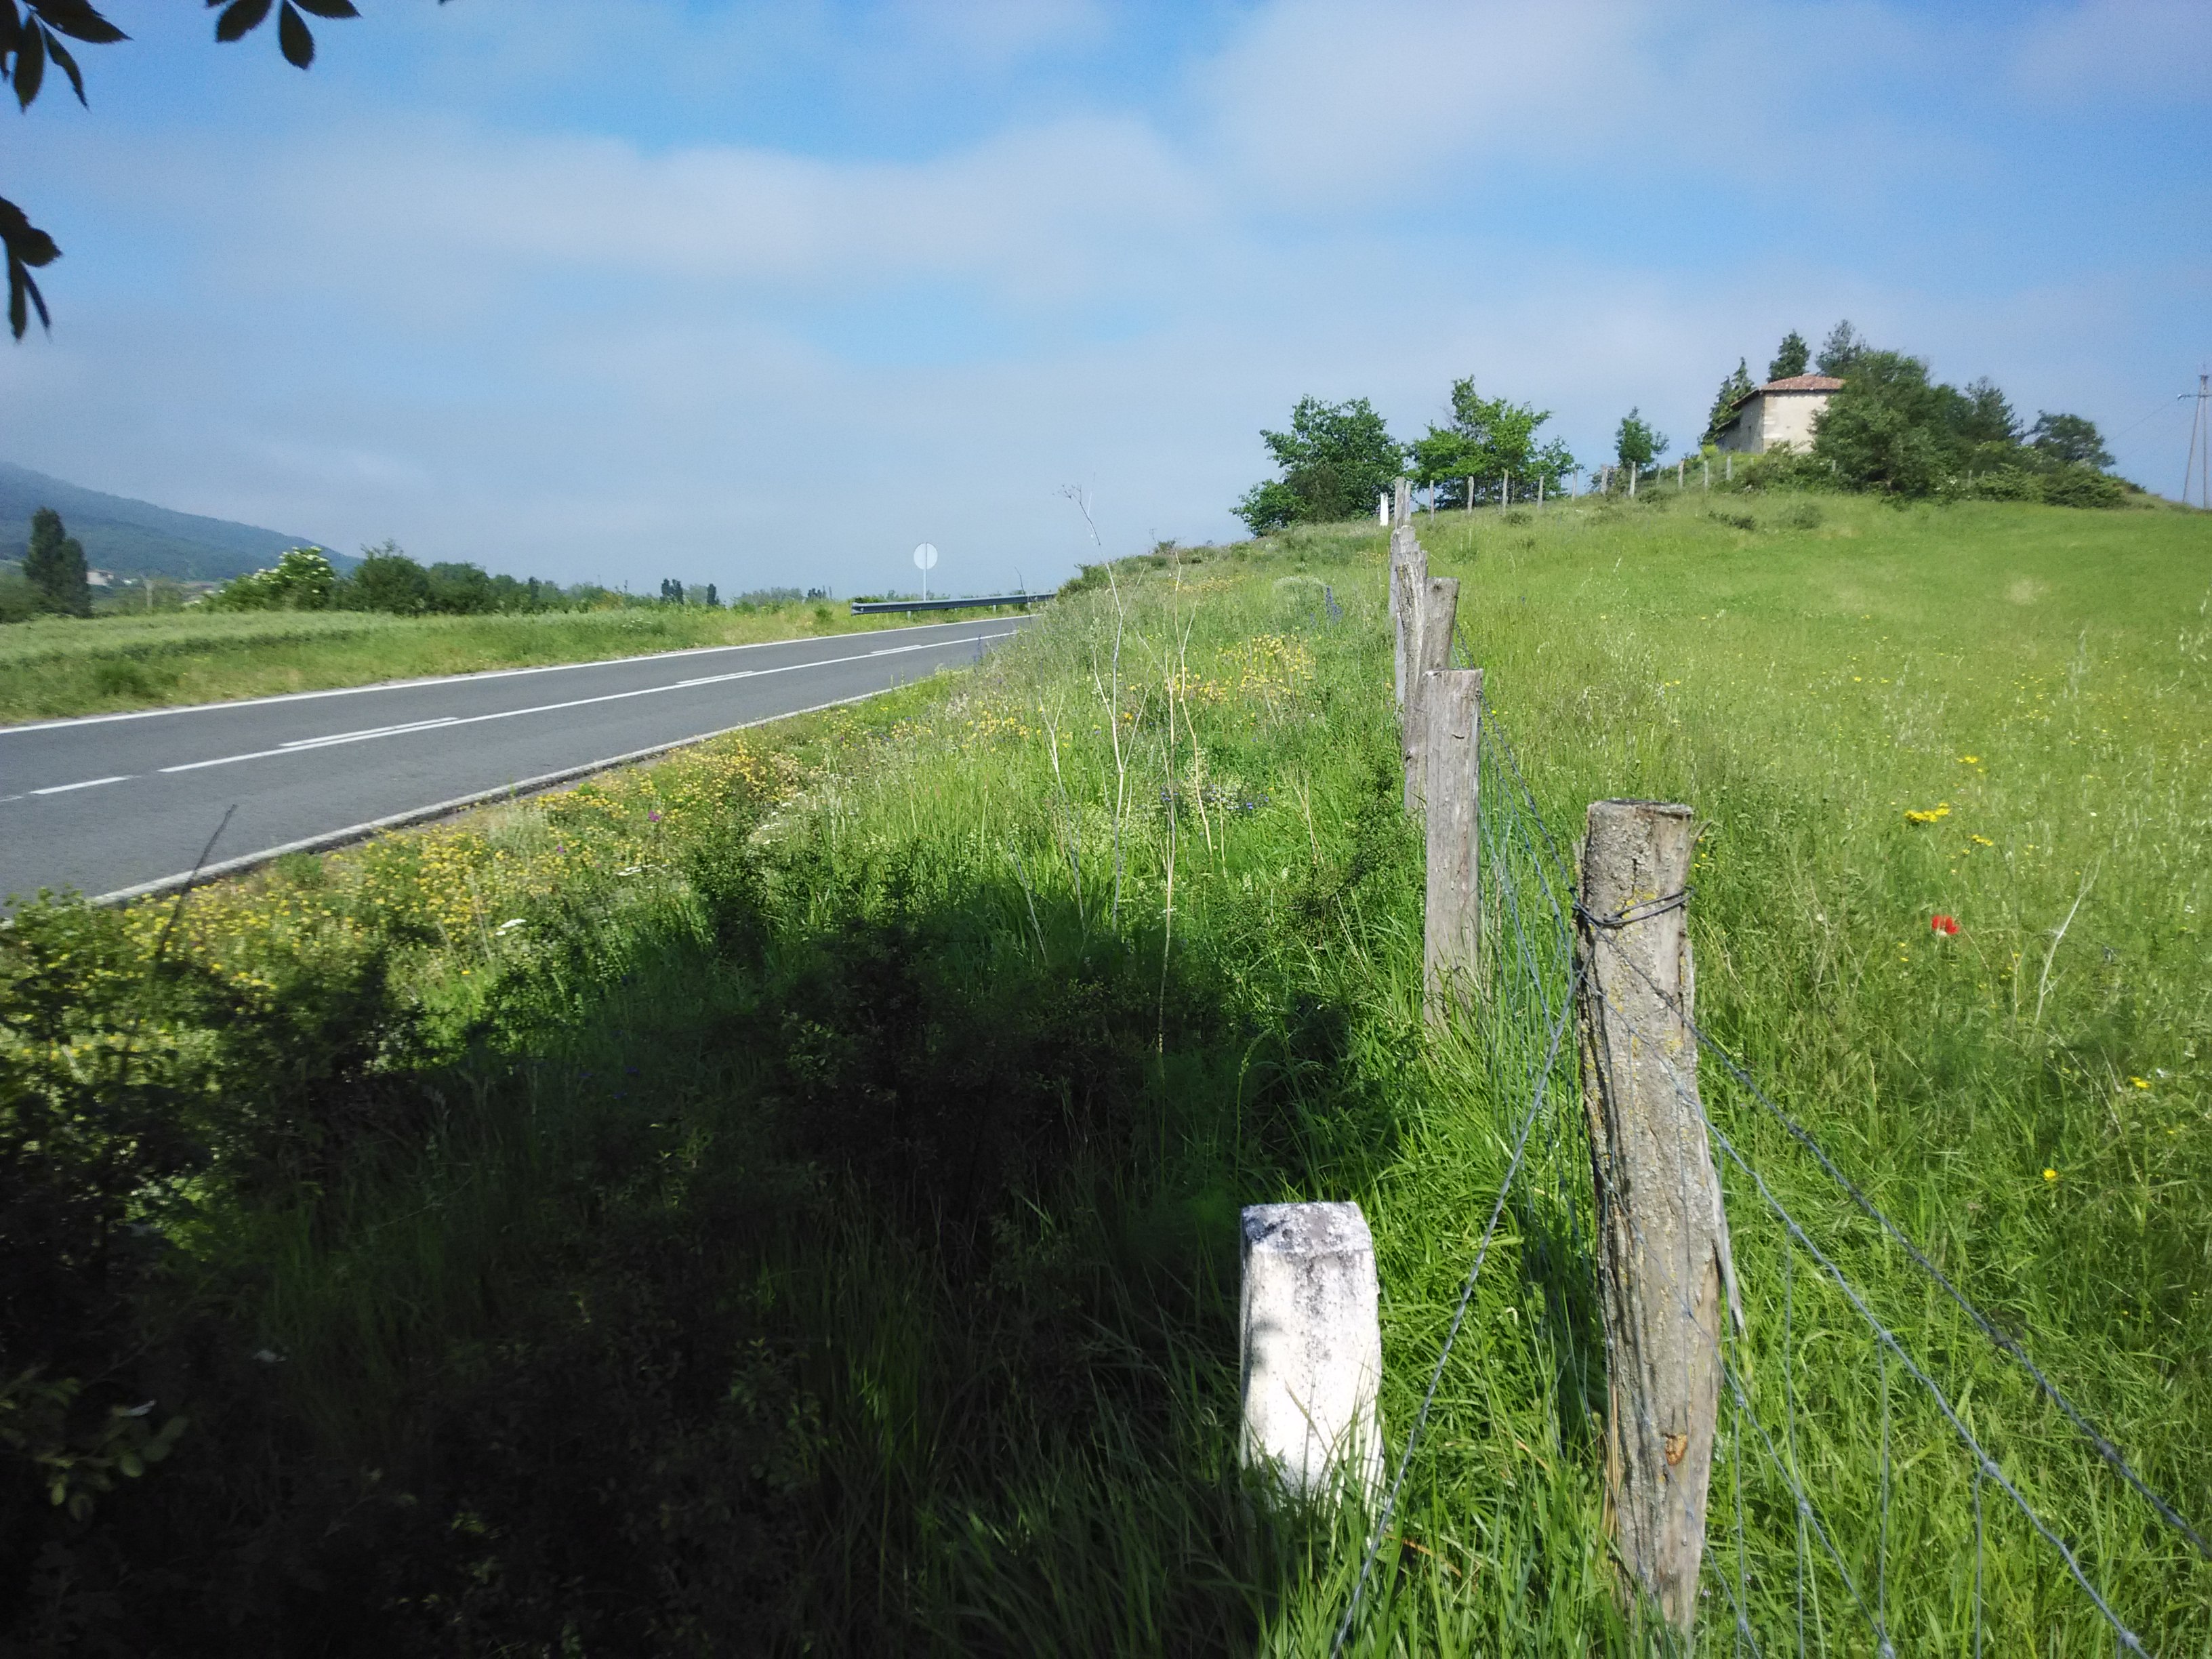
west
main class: Grassland
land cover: Grassland with sparse tree/shrub cover
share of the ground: 25 - 50 %
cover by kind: consolidated bare surface 50 %, herbaceous plants 40 %, broadleaved forest trees 5 %, shrubs 5 %
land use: Agriculture (excluding fallow land and kitchen gardens)
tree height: < 5 m
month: June
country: ES
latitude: 42.8712
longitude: -2.2756
